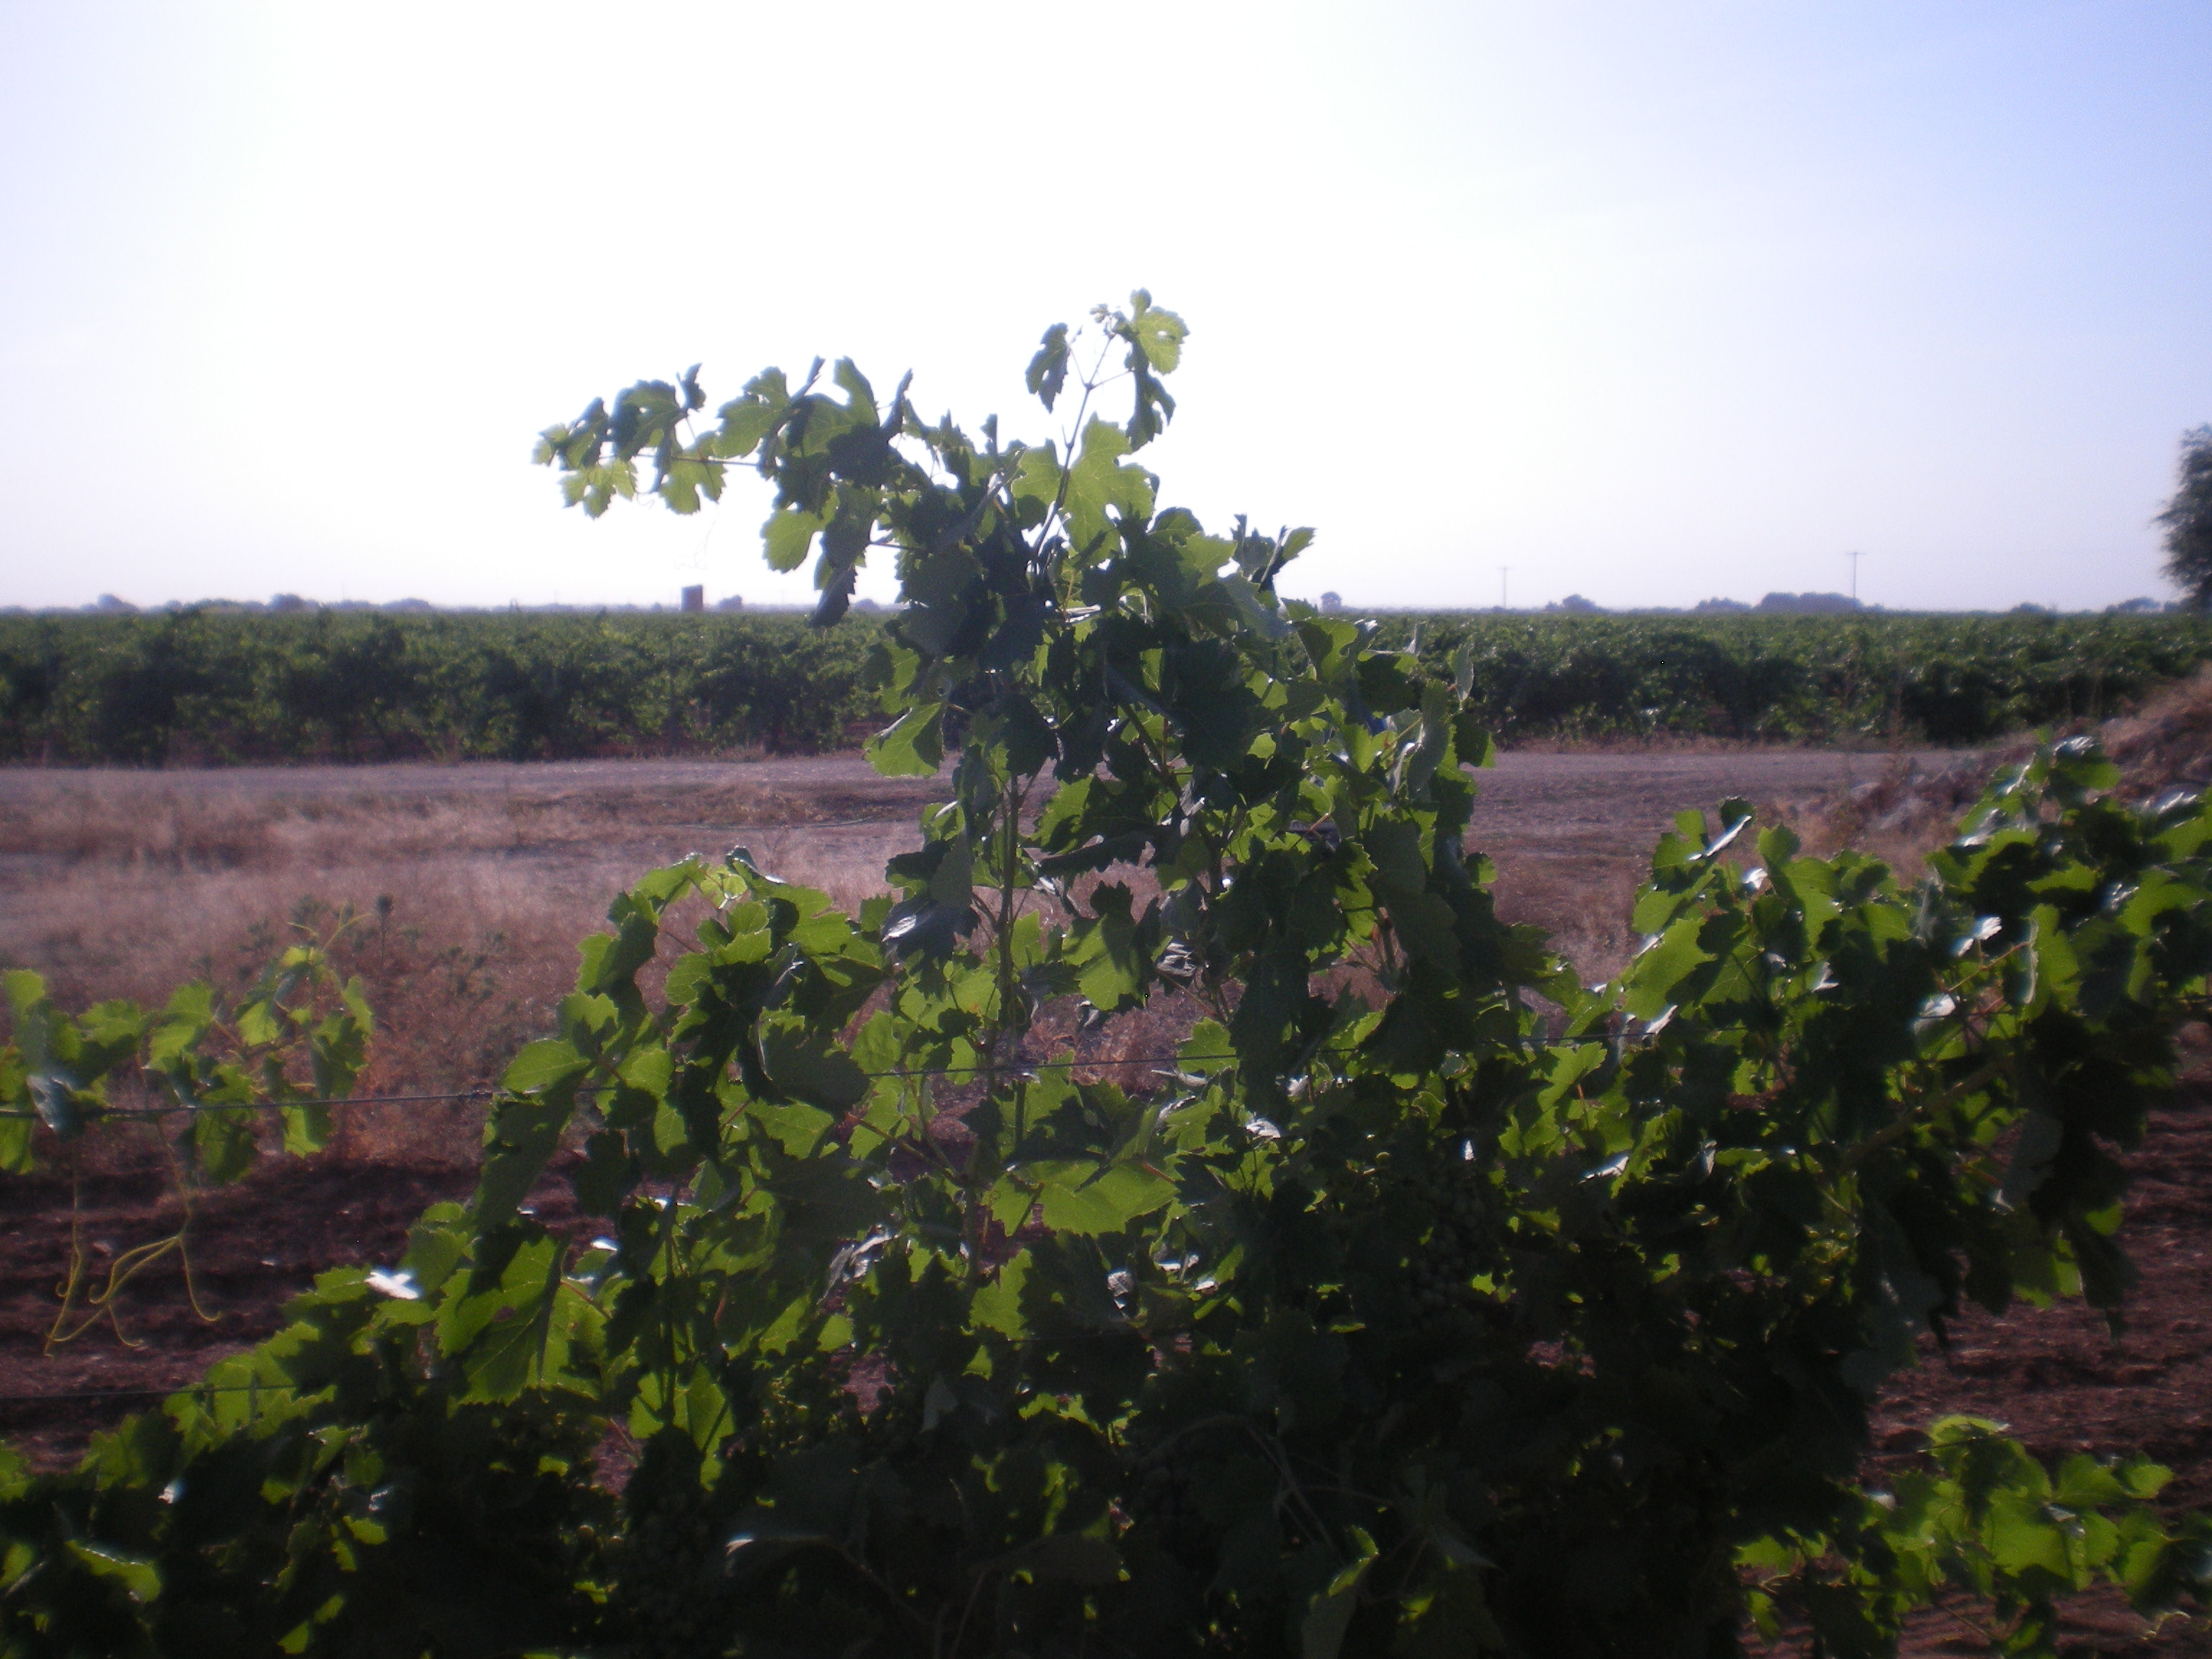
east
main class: Cropland
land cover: Vineyards
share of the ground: 10 - 25 %
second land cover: Other bare soil
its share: > 75 %
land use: Agriculture (excluding fallow land and kitchen gardens)
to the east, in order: Vineyards; Other bare soil; Grassland without tree/shrub cover; Tracks; Grass margins; Vineyards; Grass margins; Tracks; Grass margins; Vineyards
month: July
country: ES
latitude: 39.3940
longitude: -3.0323
